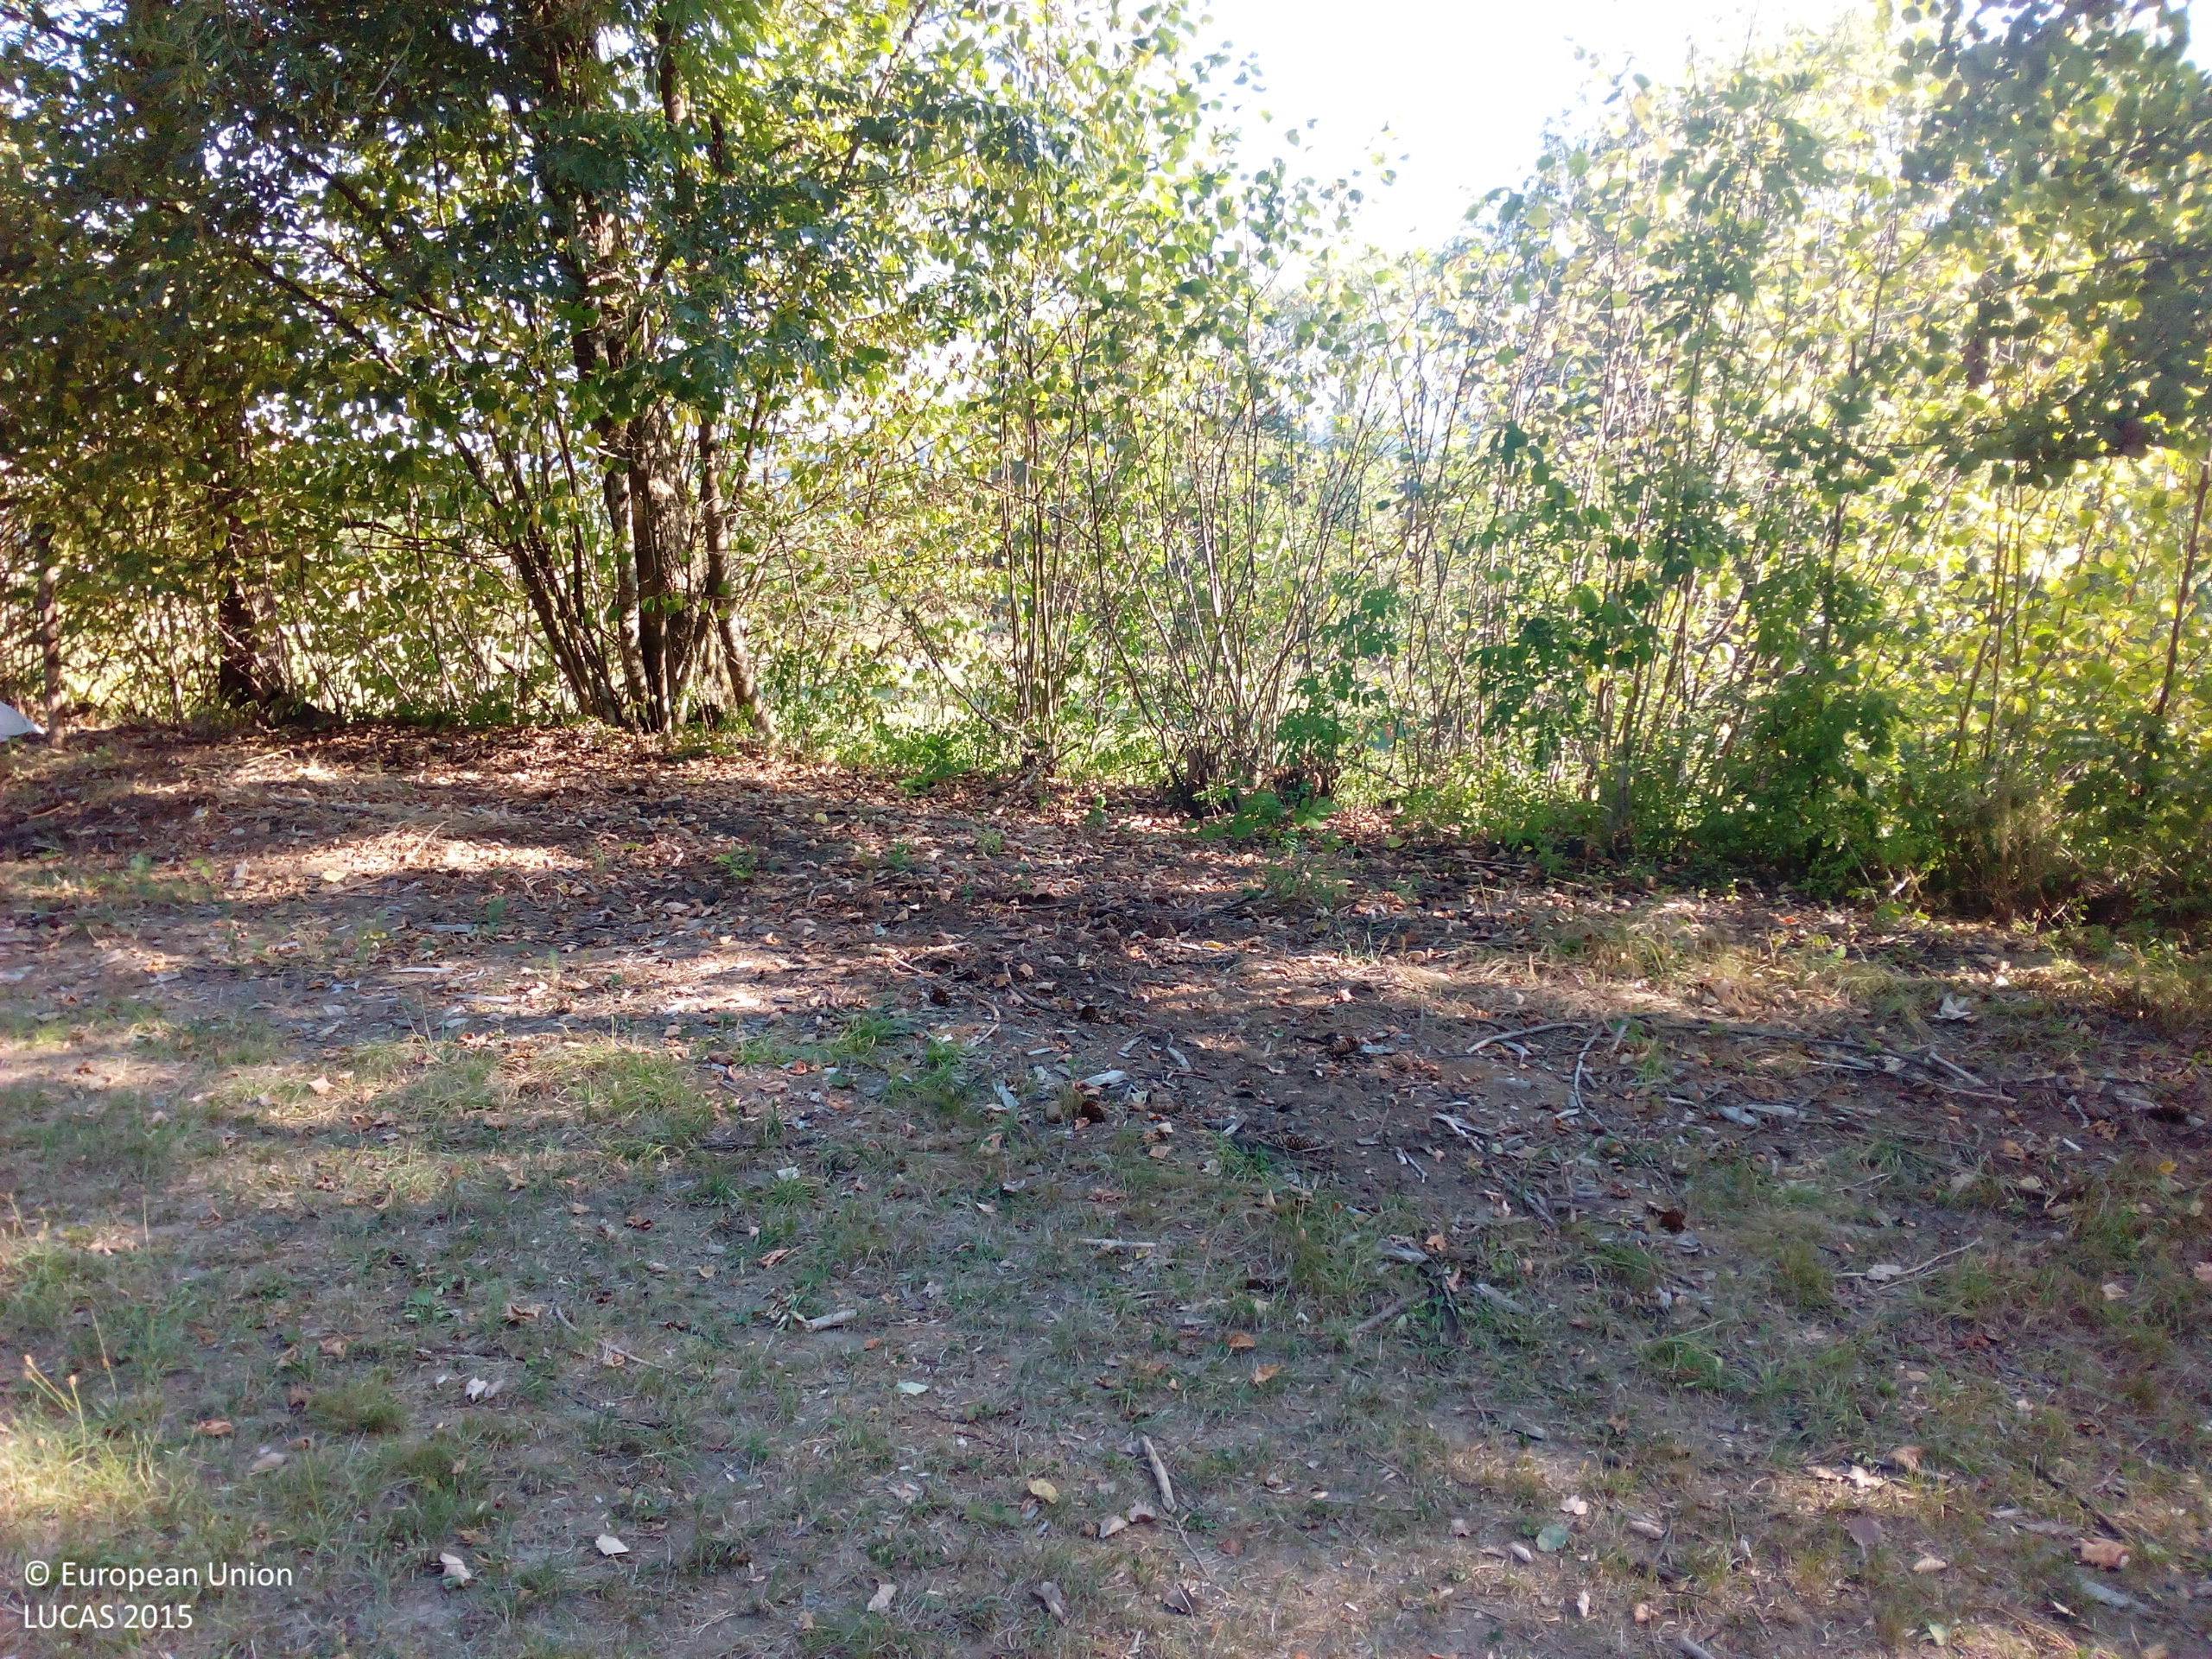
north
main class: Grassland
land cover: Grassland without tree/shrub cover
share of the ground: 50 - 75 %
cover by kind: herbaceous plants 70 %, unconsolidated bare surface 30 %
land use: Agriculture (excluding fallow land and kitchen gardens)
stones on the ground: < 10 %
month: September
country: DE
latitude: 48.8573
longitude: 13.3390
